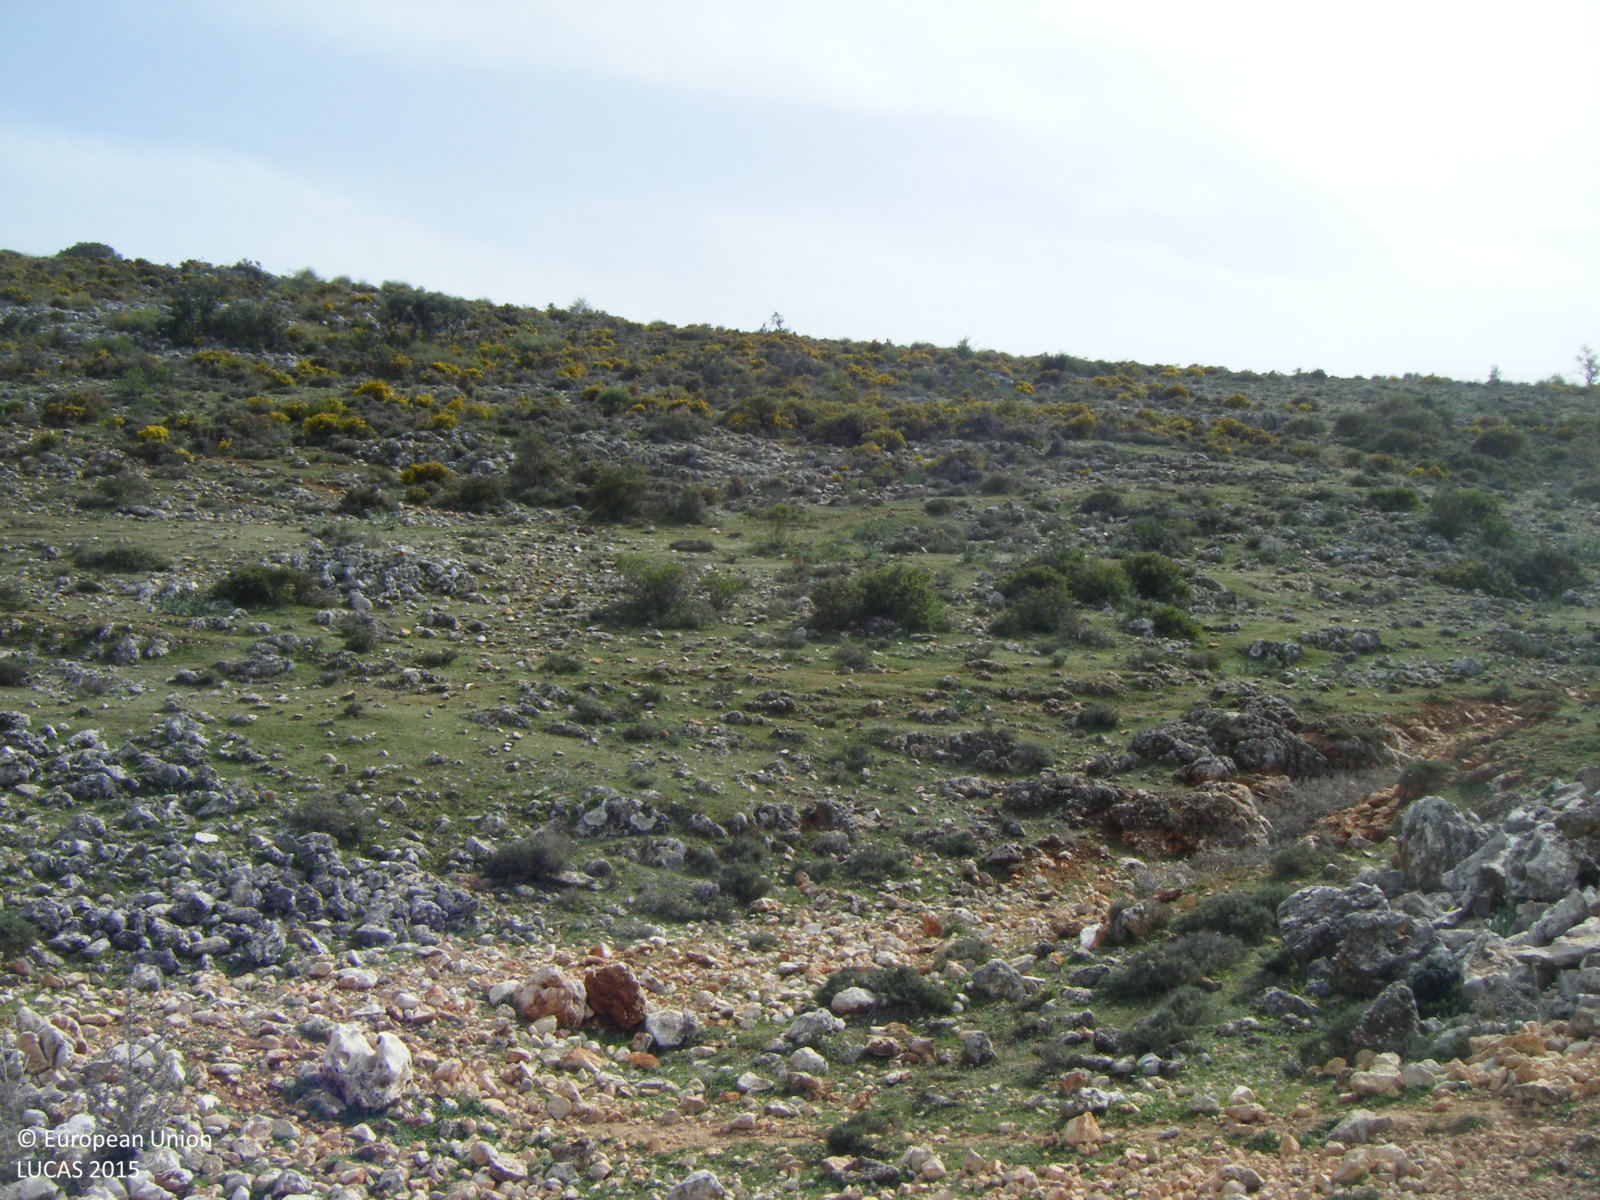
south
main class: Shrubland
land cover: Shrubland without tree cover
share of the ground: > 75 %
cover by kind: shrubs 75 %, herbaceous plants 25 %
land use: Semi-natural and natural areas not in use
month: April
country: ES
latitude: 37.0435
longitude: -4.0798
